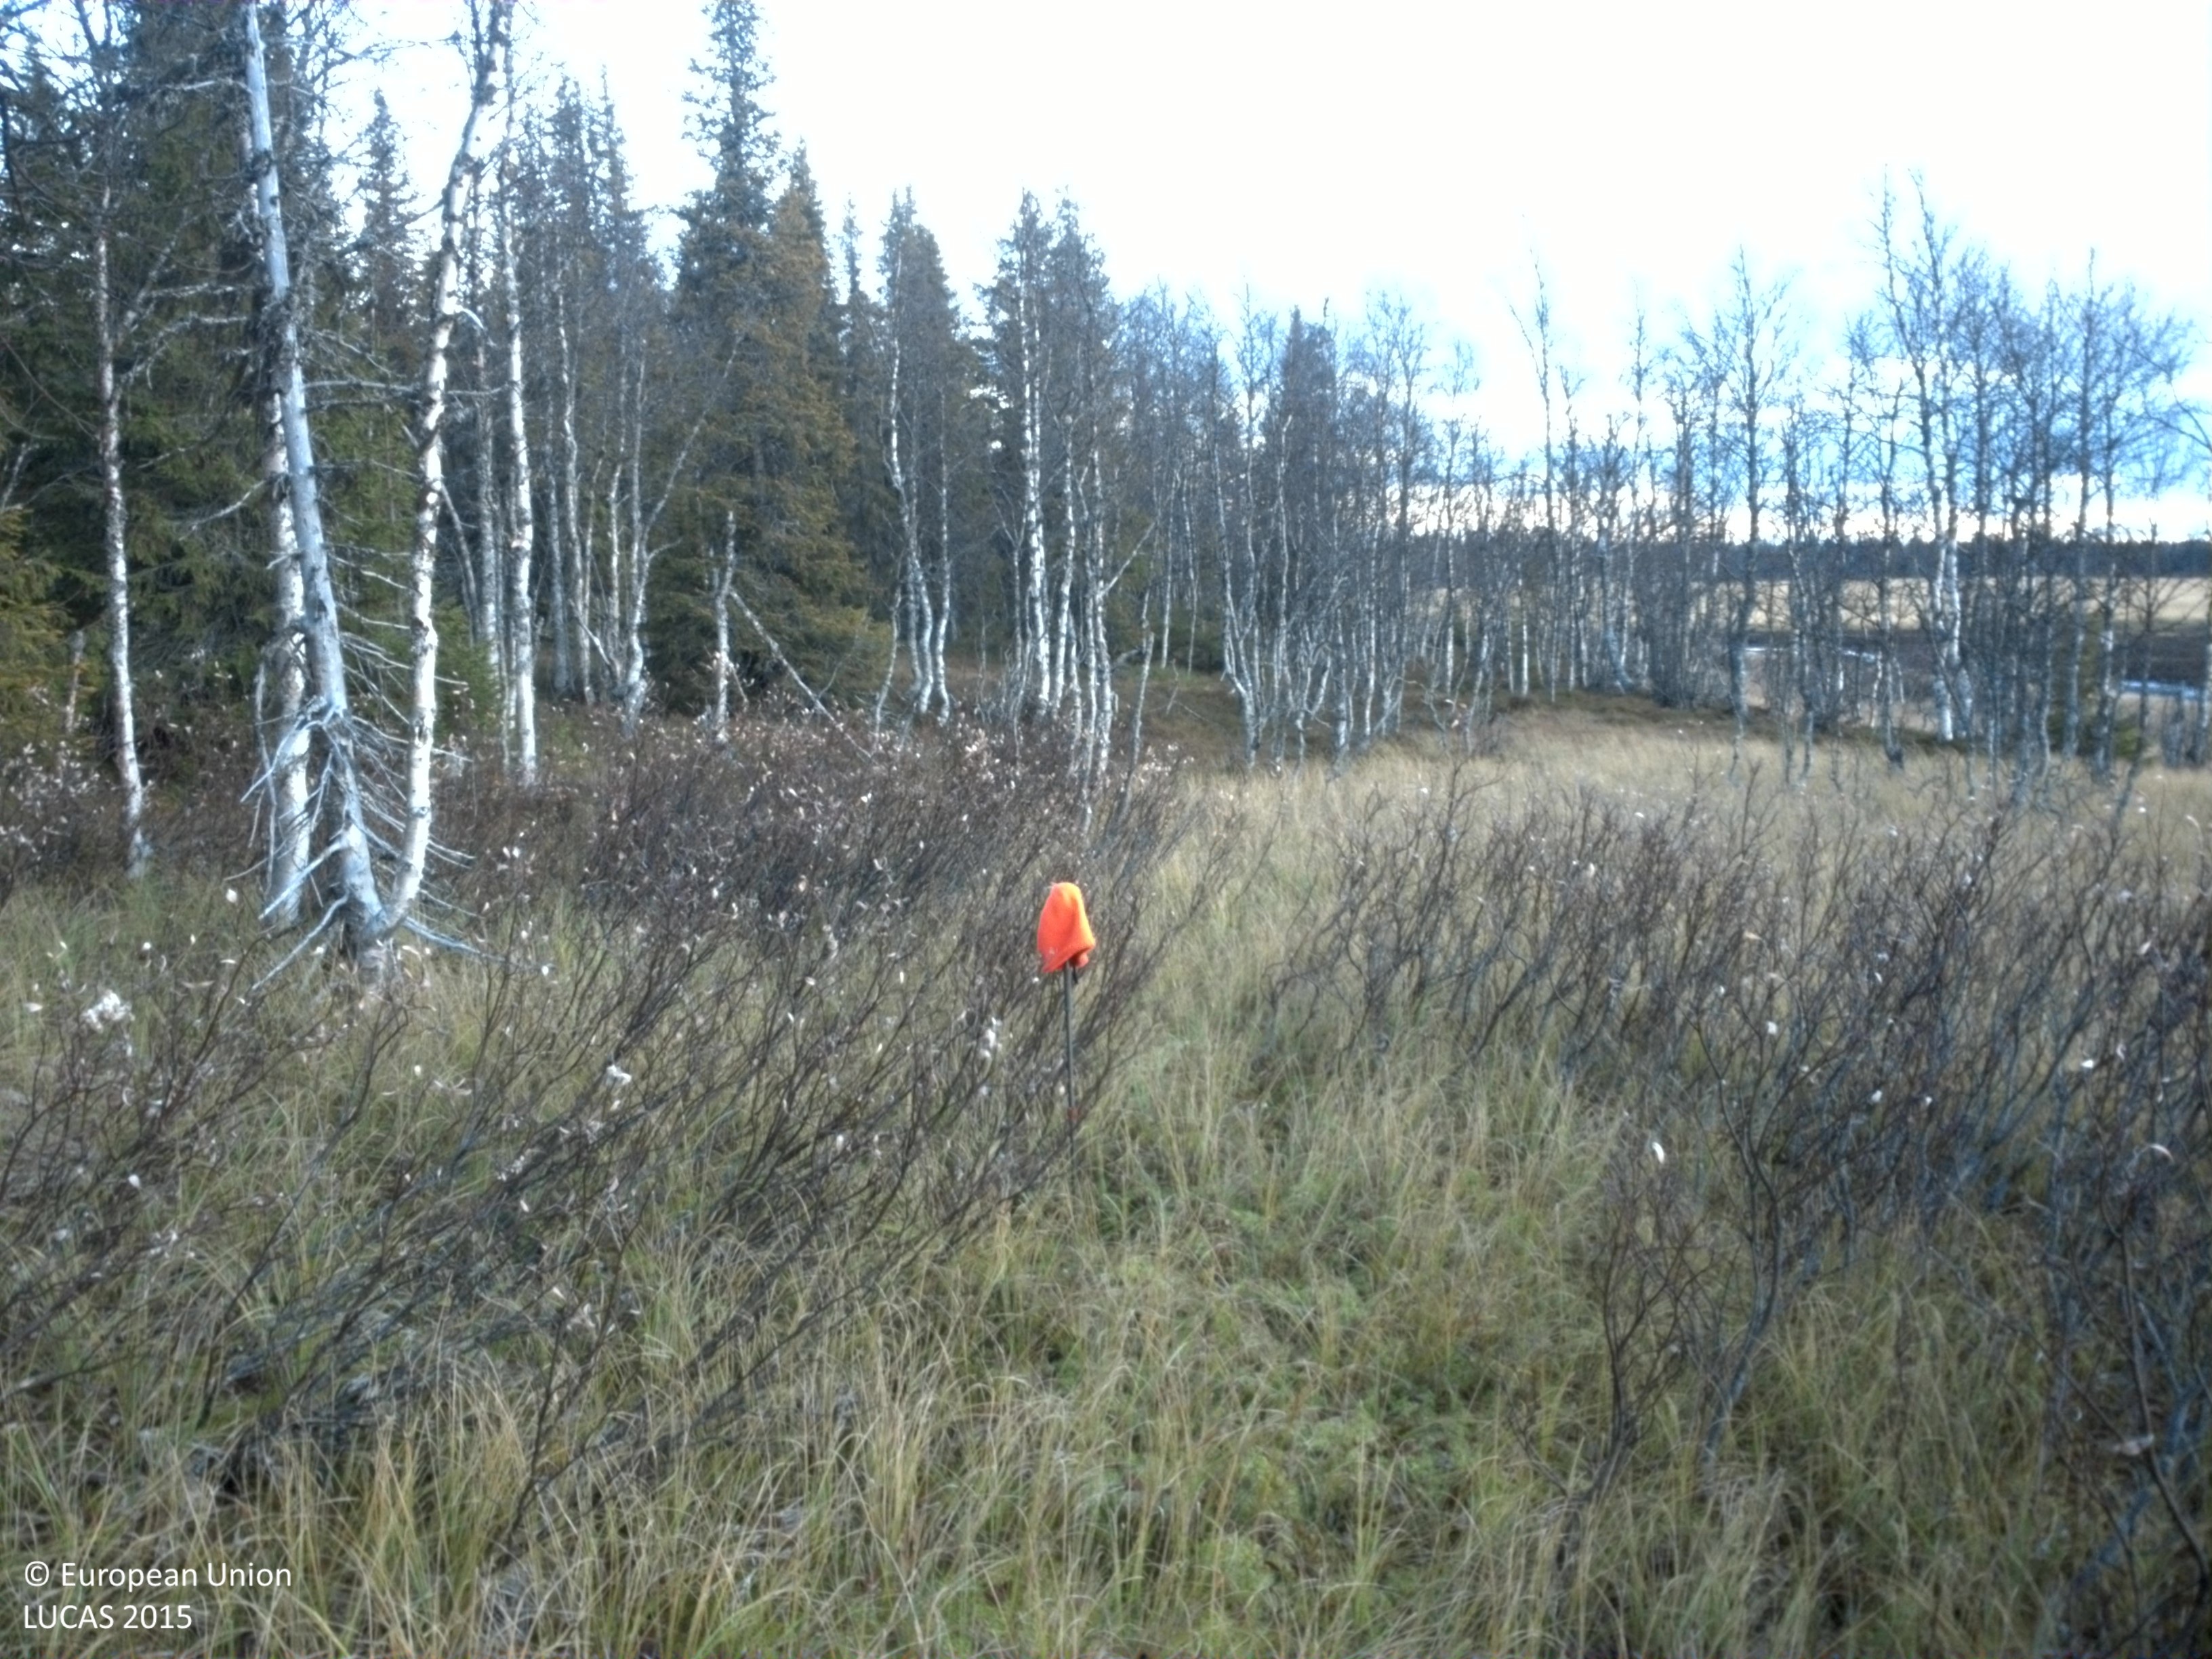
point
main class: Shrubland
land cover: Shrubland without tree cover
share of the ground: 25 - 50 %
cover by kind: herbaceous plants 40 %, shrubs 35 %, lichens and mosses 25 %
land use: Semi-natural and natural areas not in use
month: October
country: SE
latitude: 64.7309
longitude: 17.4610
